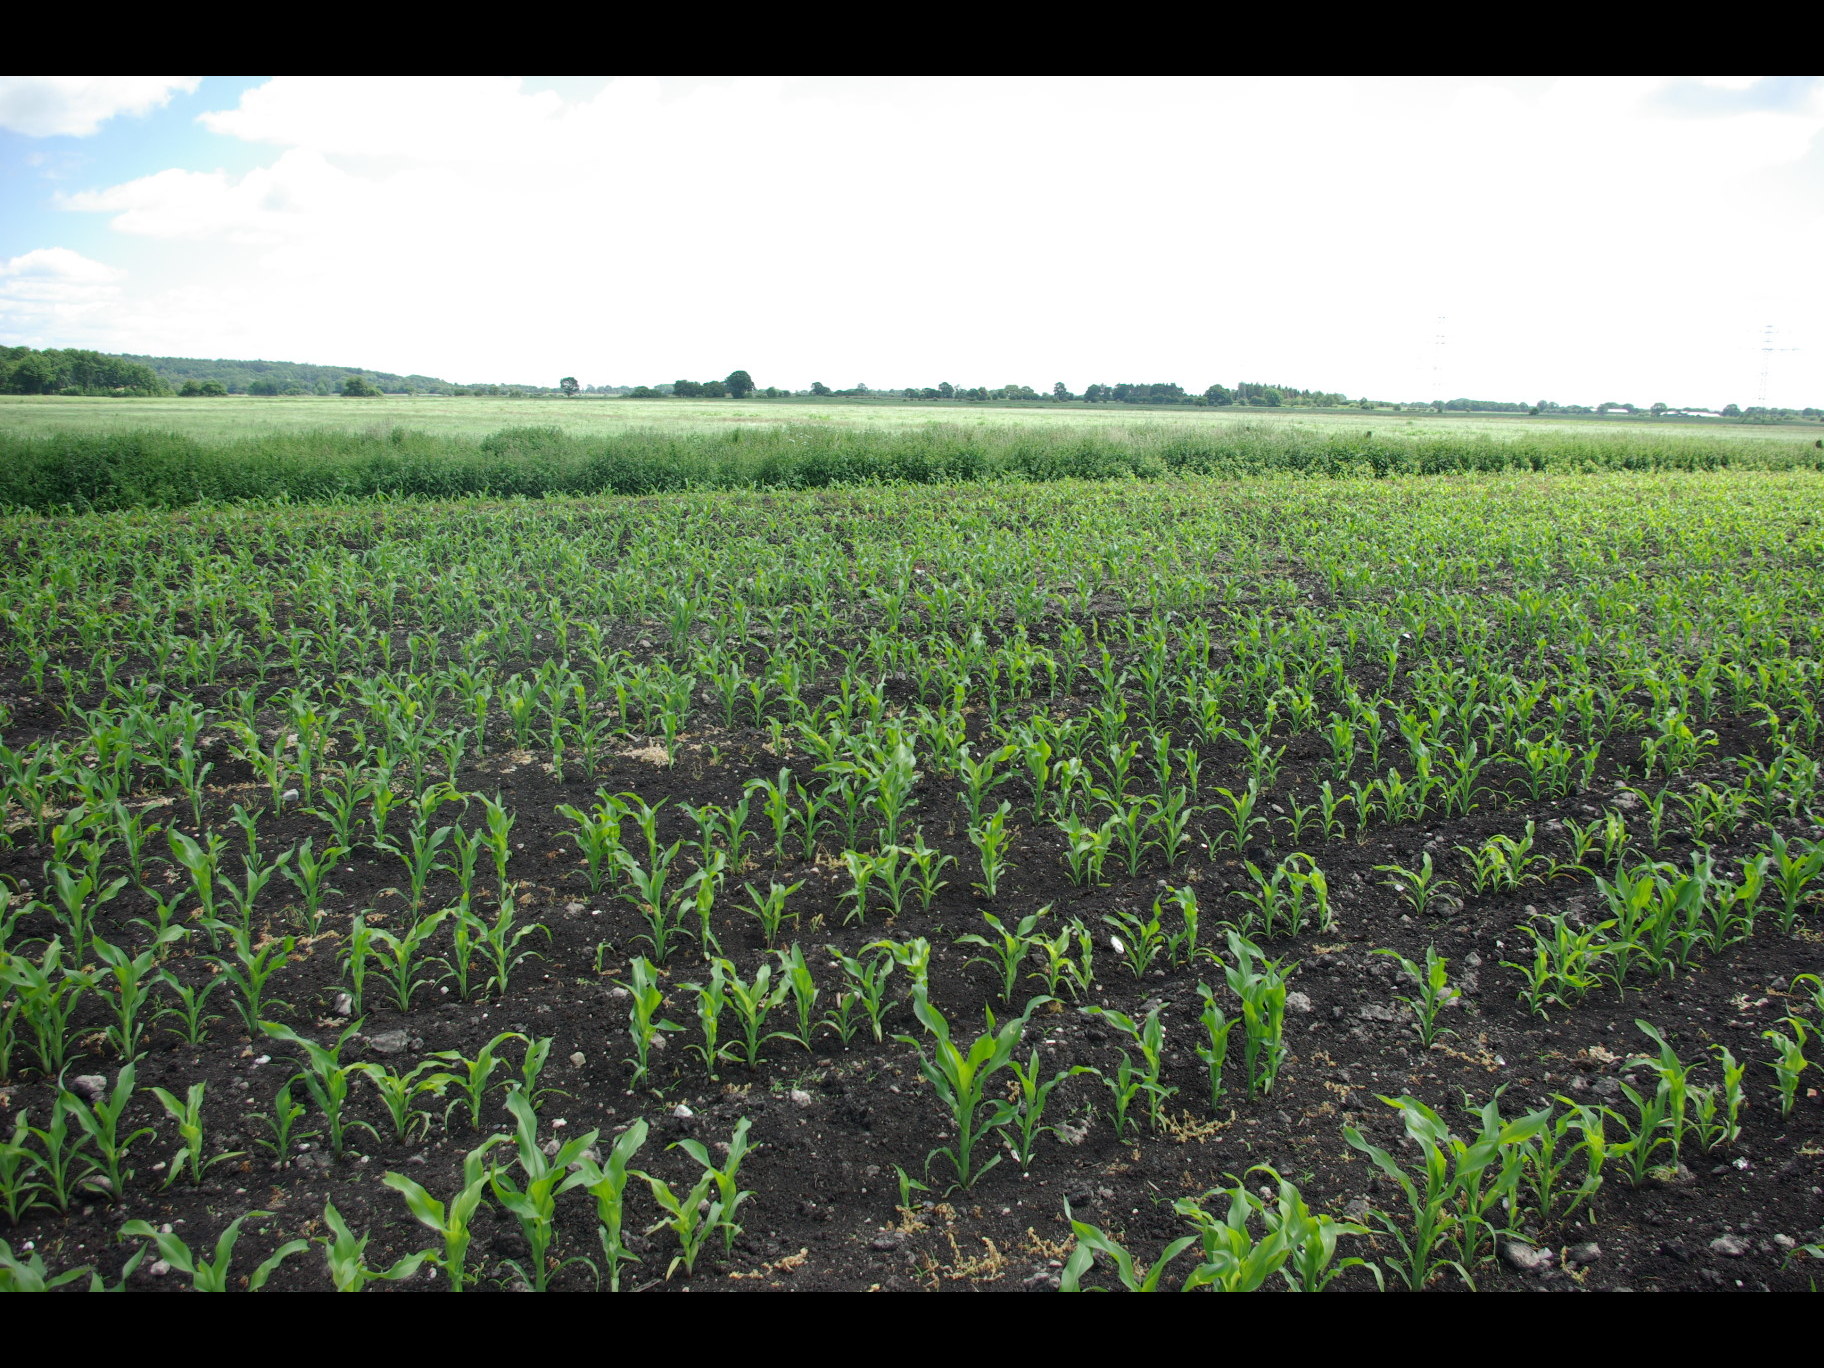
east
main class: Cropland
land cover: Maize
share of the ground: 25 - 50 %
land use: Agriculture (excluding fallow land and kitchen gardens)
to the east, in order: Maize; Spontaneously vegetated surfaces; Ditches and canals; Spontaneously vegetated surfaces; Grassland without tree/shrub cover
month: June
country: DE
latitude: 54.3539
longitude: 9.6463
